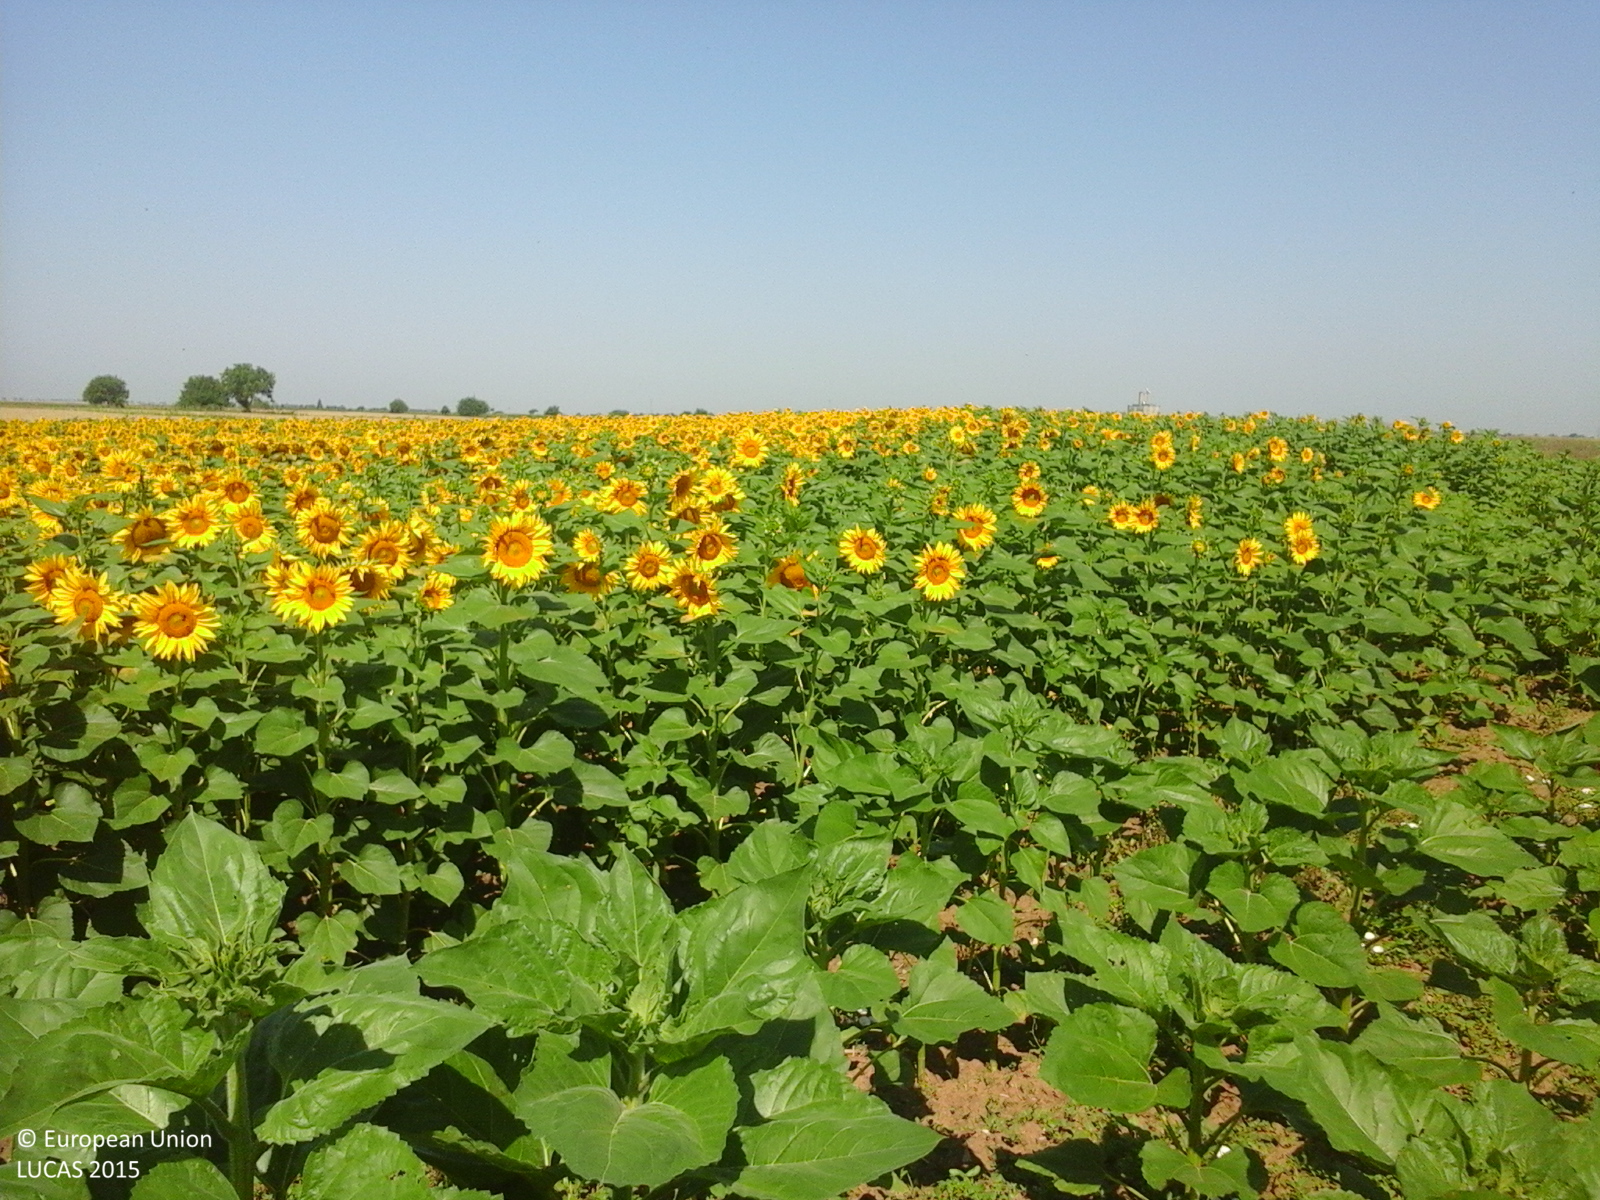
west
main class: Cropland
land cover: Sunflower
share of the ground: > 75 %
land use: Agriculture (excluding fallow land and kitchen gardens)
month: July
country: RO
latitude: 44.1025
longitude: 24.6999
